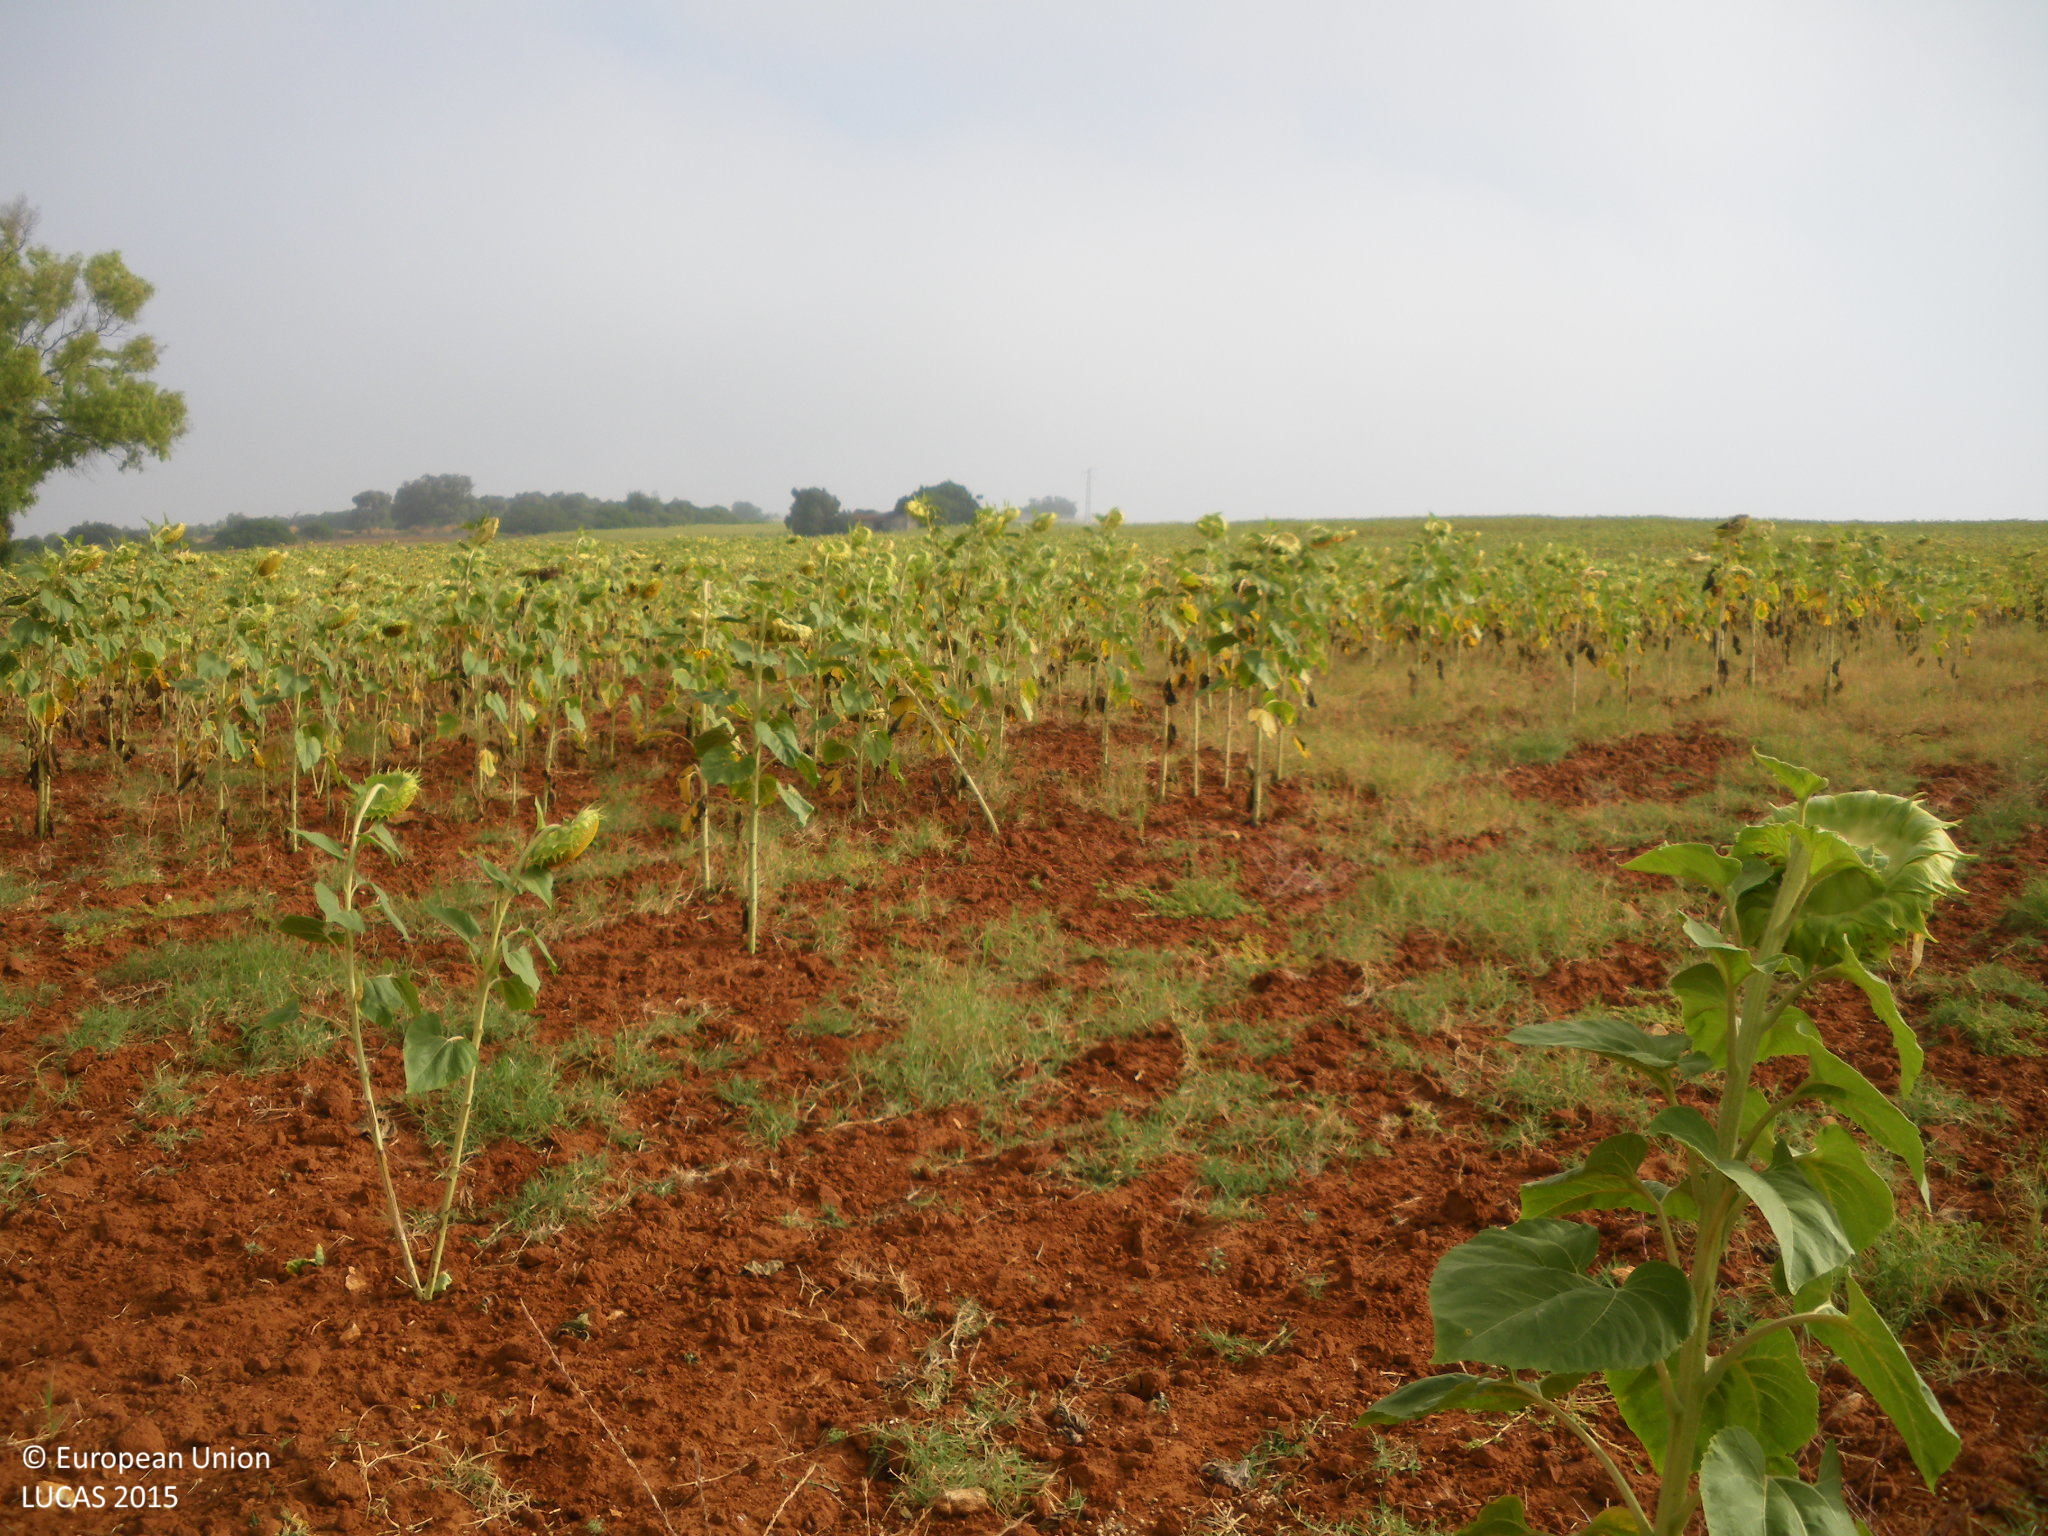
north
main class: Cropland
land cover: Sunflower
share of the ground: < 10 %
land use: Agriculture (excluding fallow land and kitchen gardens)
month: July
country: ES
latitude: 36.7409
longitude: -5.7420
